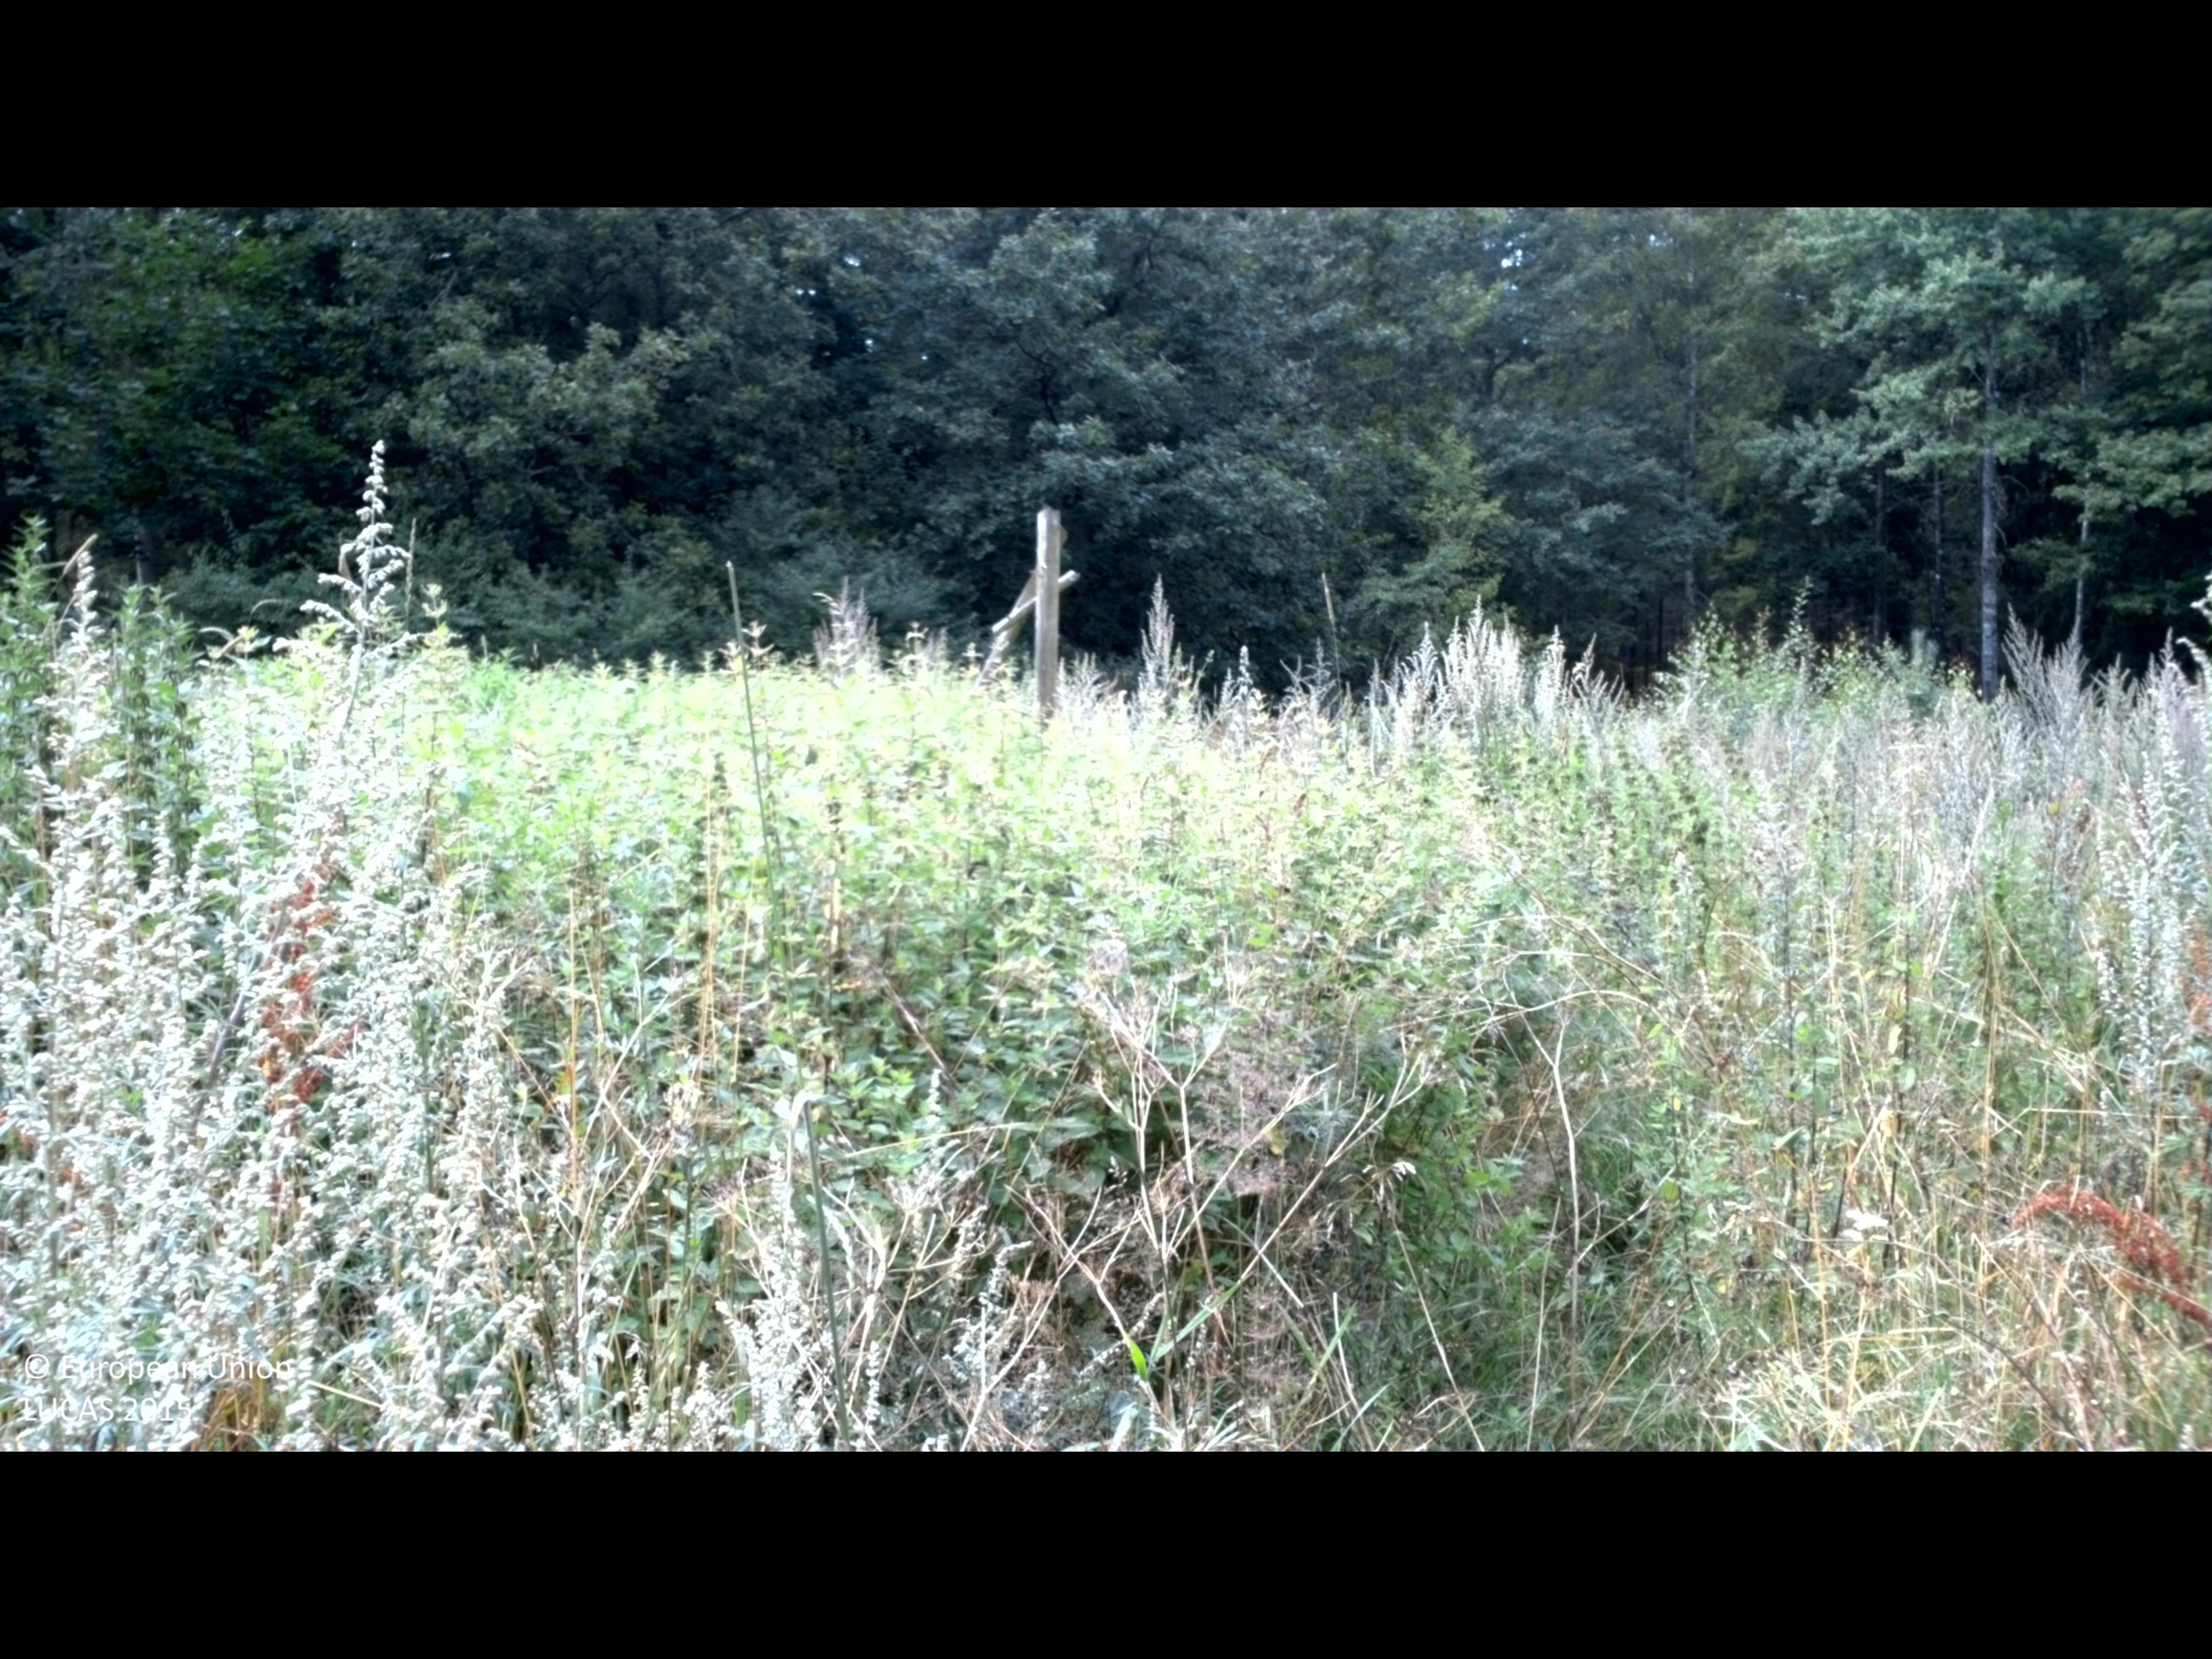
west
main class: Grassland
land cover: Grassland without tree/shrub cover
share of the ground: > 75 %
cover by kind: herbaceous plants 100 %
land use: Abandoned areas
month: August
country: SE
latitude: 56.3594
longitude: 15.0321
